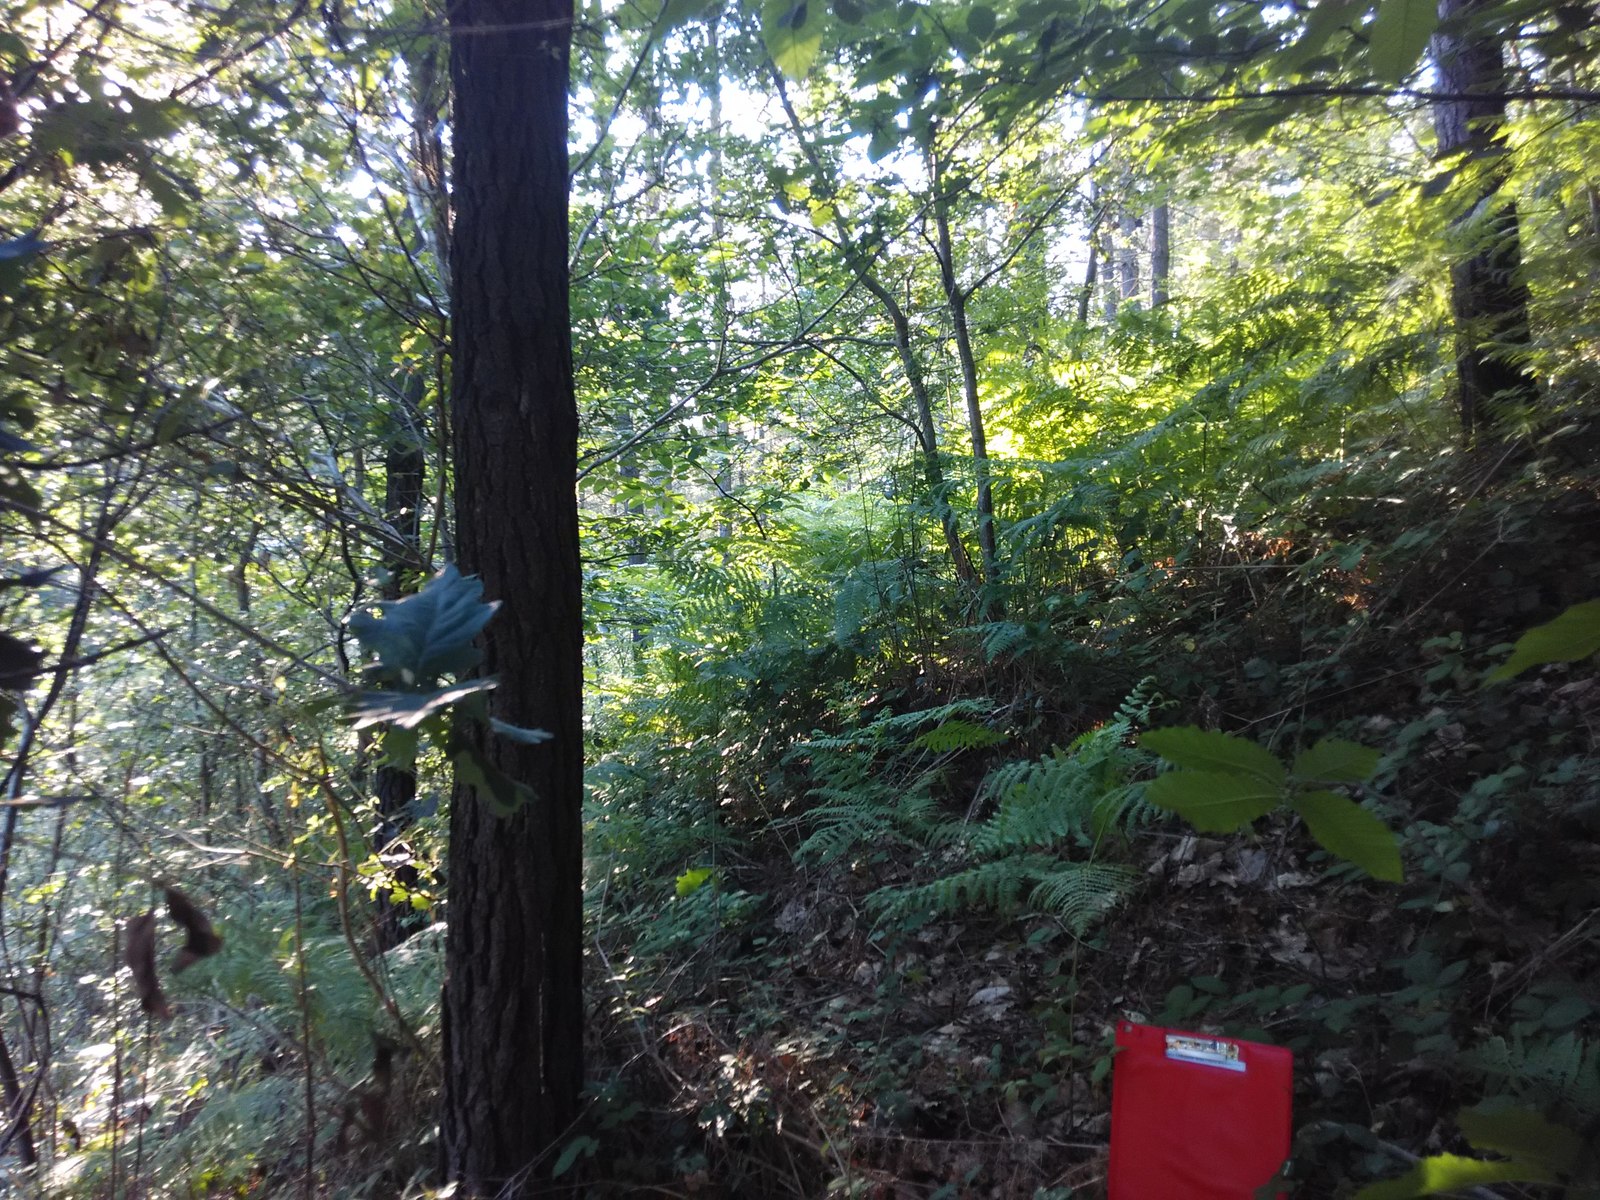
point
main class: Woodland
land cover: Other mixed woodland
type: acidophilous oak and oak-birch forest
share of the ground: > 75 %
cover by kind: coniferous forest trees 40 %, broadleaved forest trees 35 %, herbaceous plants 15 %, unconsolidated bare surface 10 %
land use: Forestry
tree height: > 5 m
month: June
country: ES
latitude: 43.0667
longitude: -2.4659
